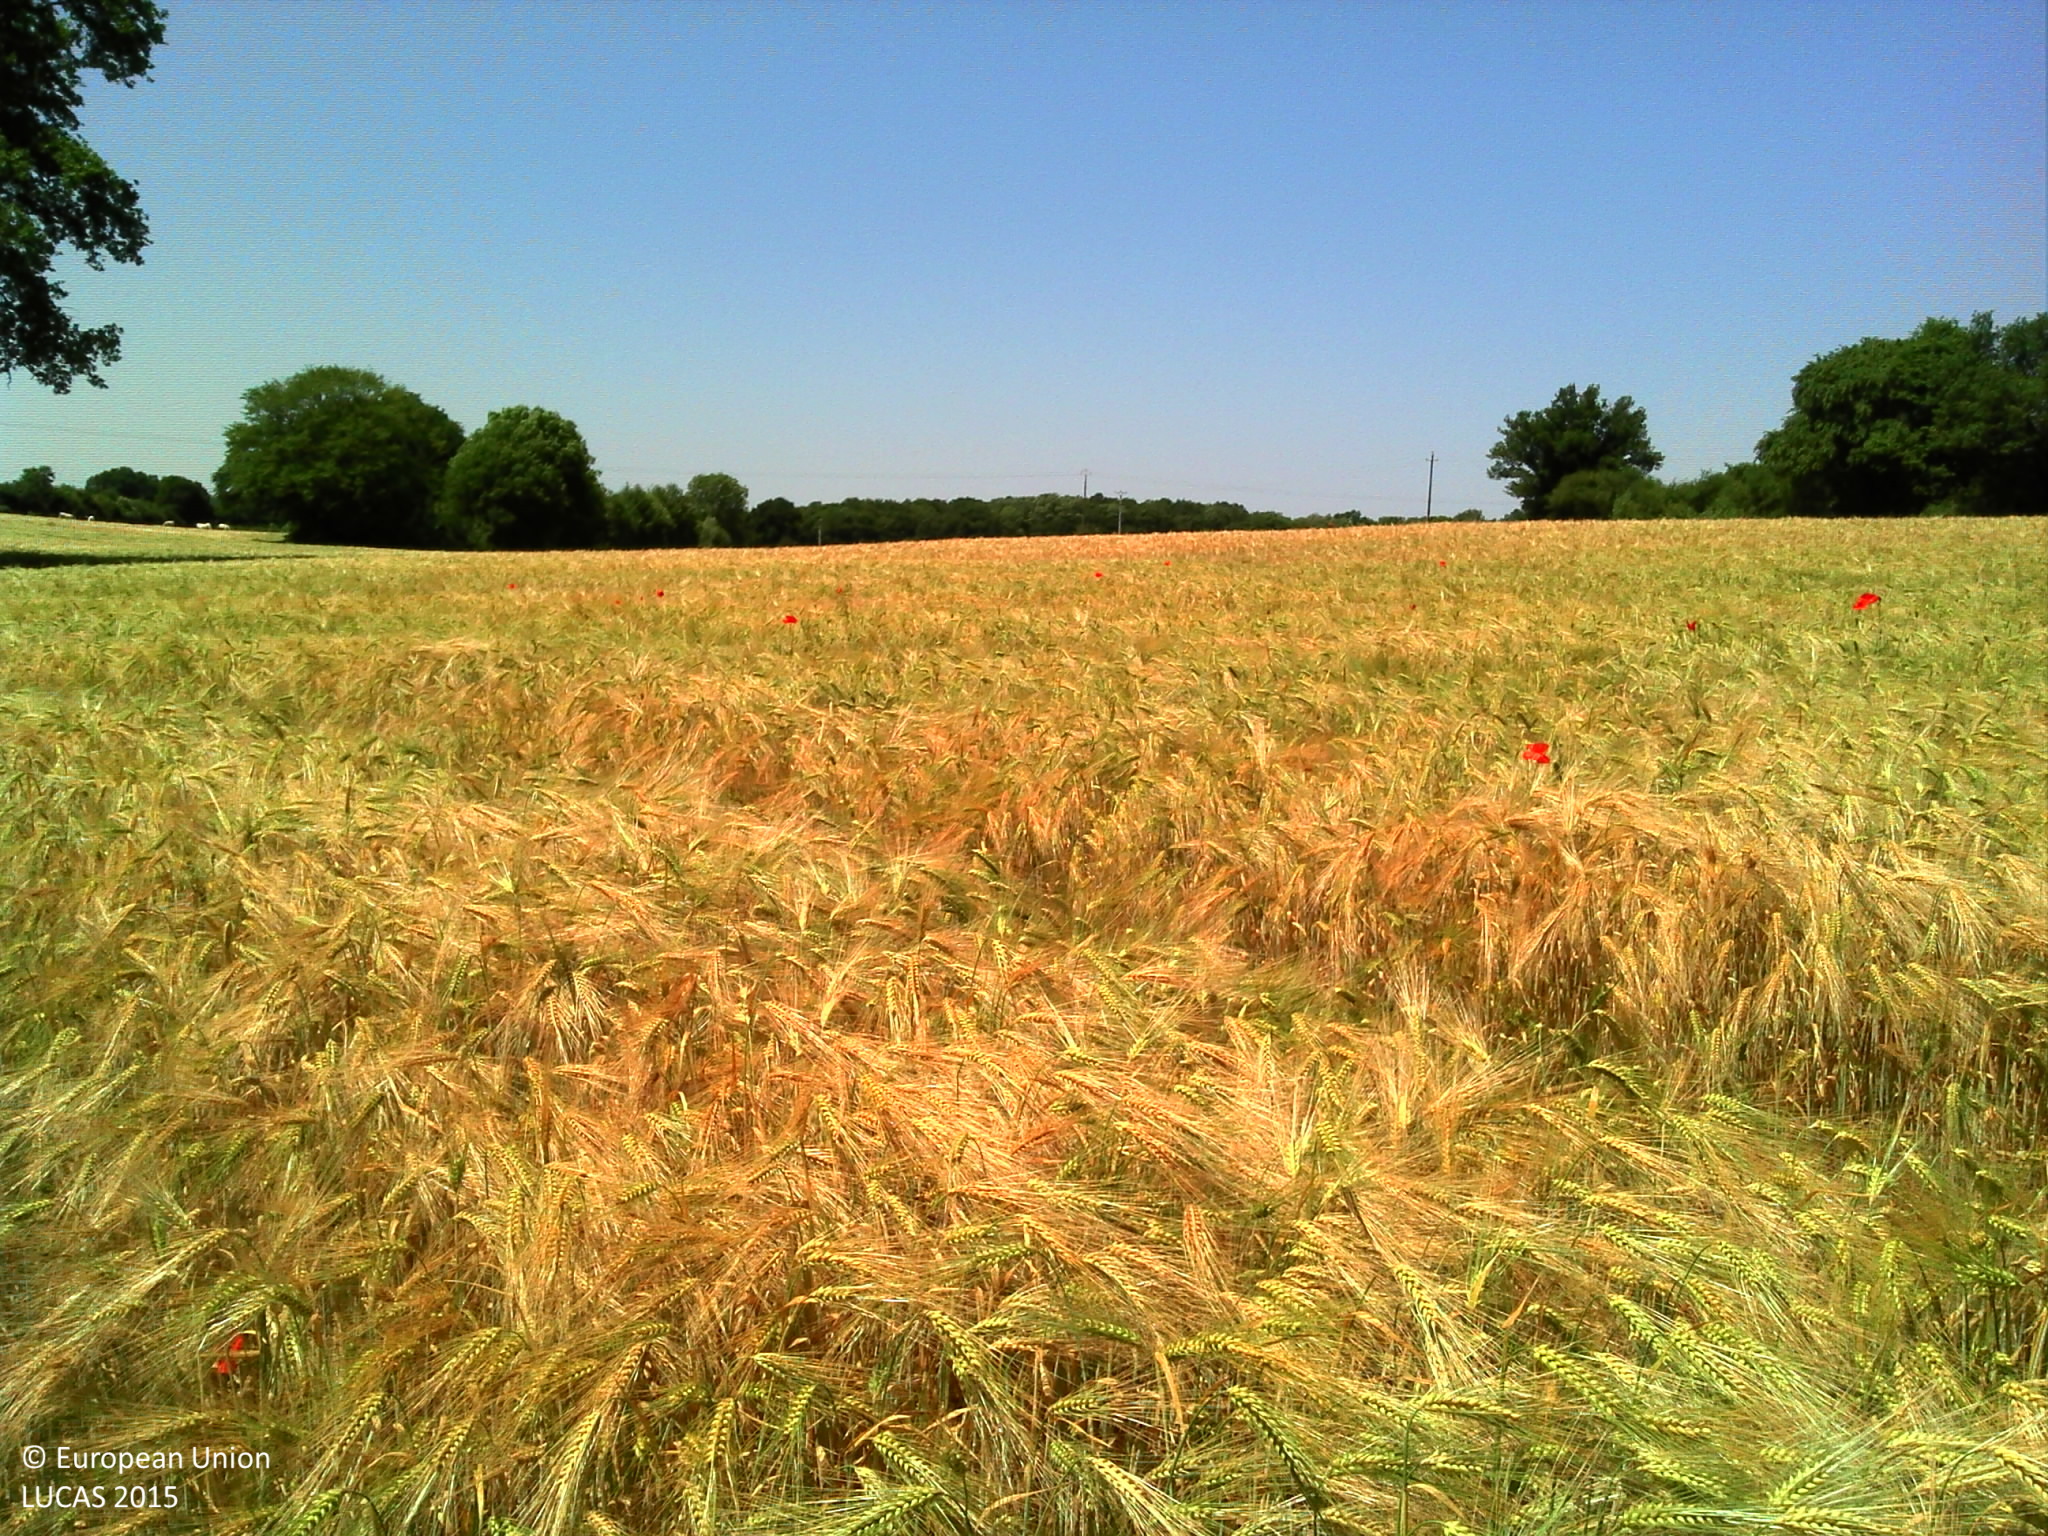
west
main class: Cropland
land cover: Barley
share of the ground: > 75 %
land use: Agriculture (excluding fallow land and kitchen gardens)
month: June
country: FR
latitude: 46.8955
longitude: 2.9473
